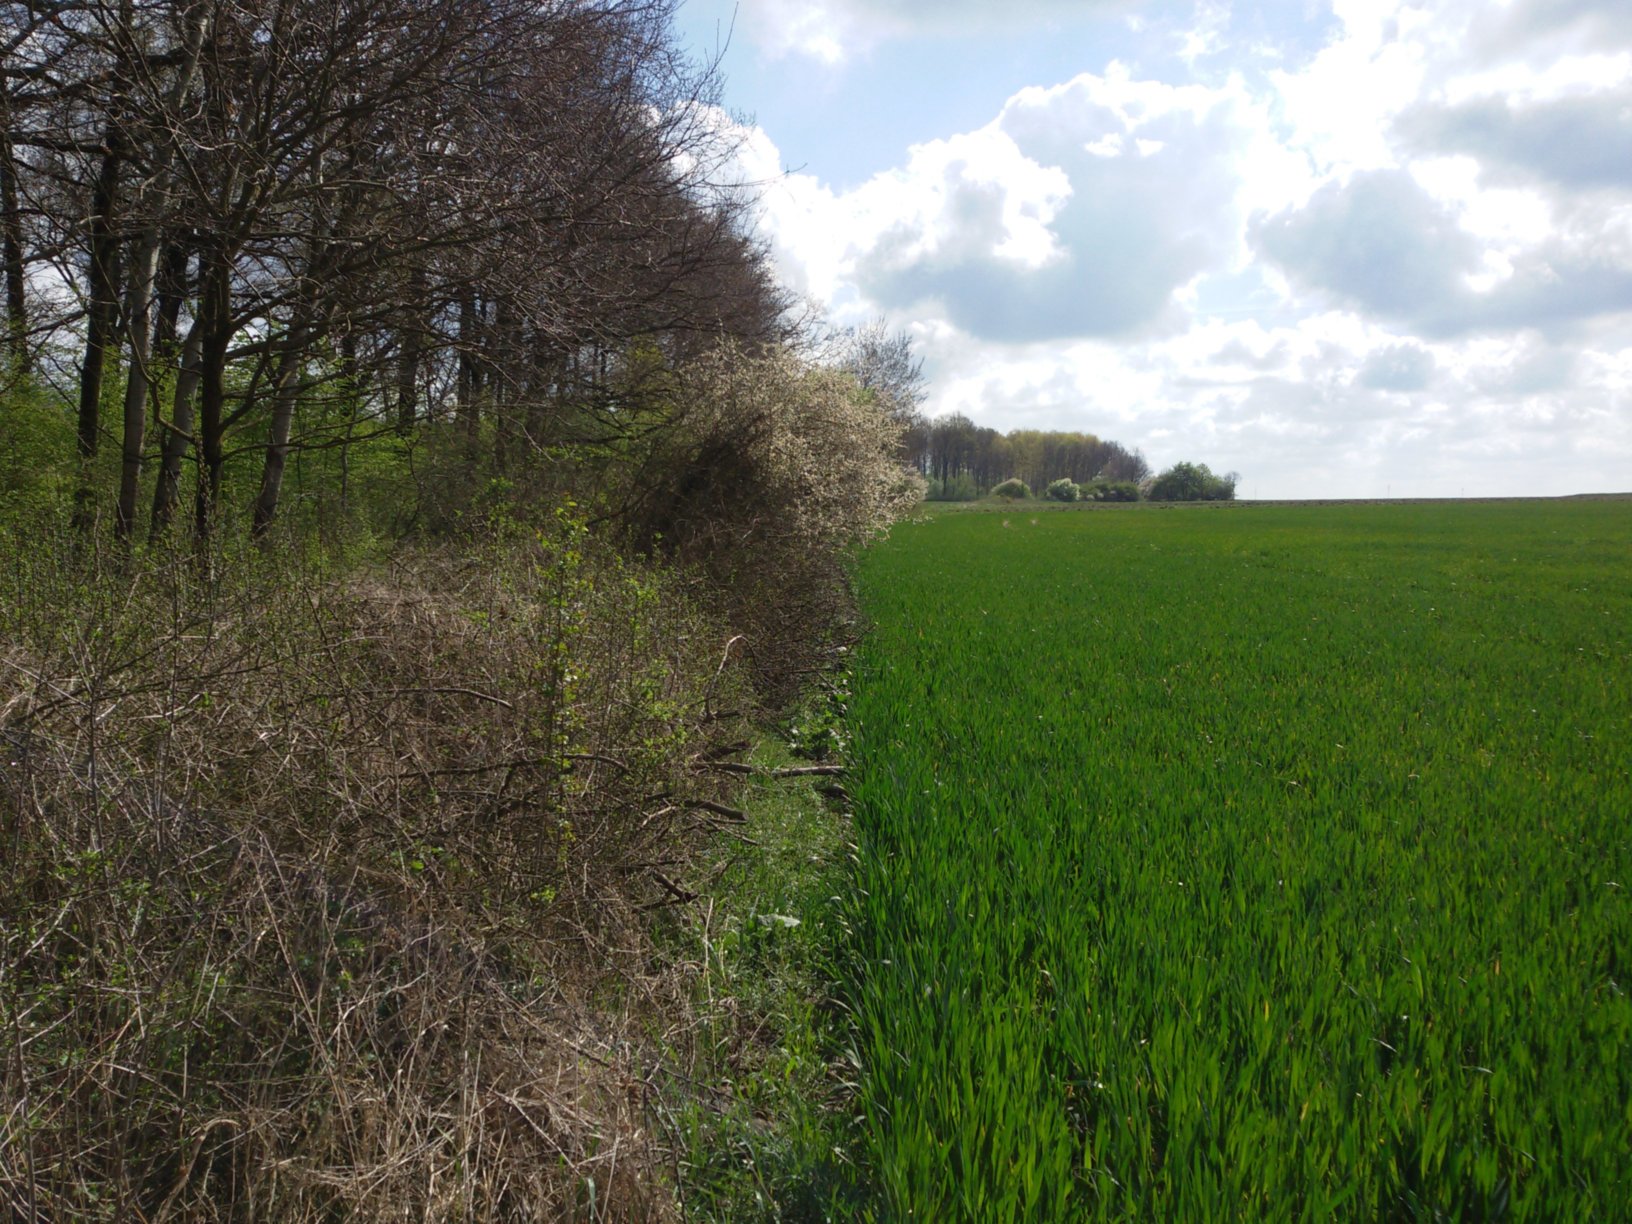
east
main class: Woodland
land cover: Broadleaved woodland
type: mesophytic deciduous forest
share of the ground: > 75 %
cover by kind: broadleaved forest trees 80 %, shrubs 20 %
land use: Semi-natural and natural areas not in use
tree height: > 5 m
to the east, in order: Broadleaved woodland; Abandoned hedges; Barley
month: April
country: PL
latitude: 51.5832
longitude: 15.5028
